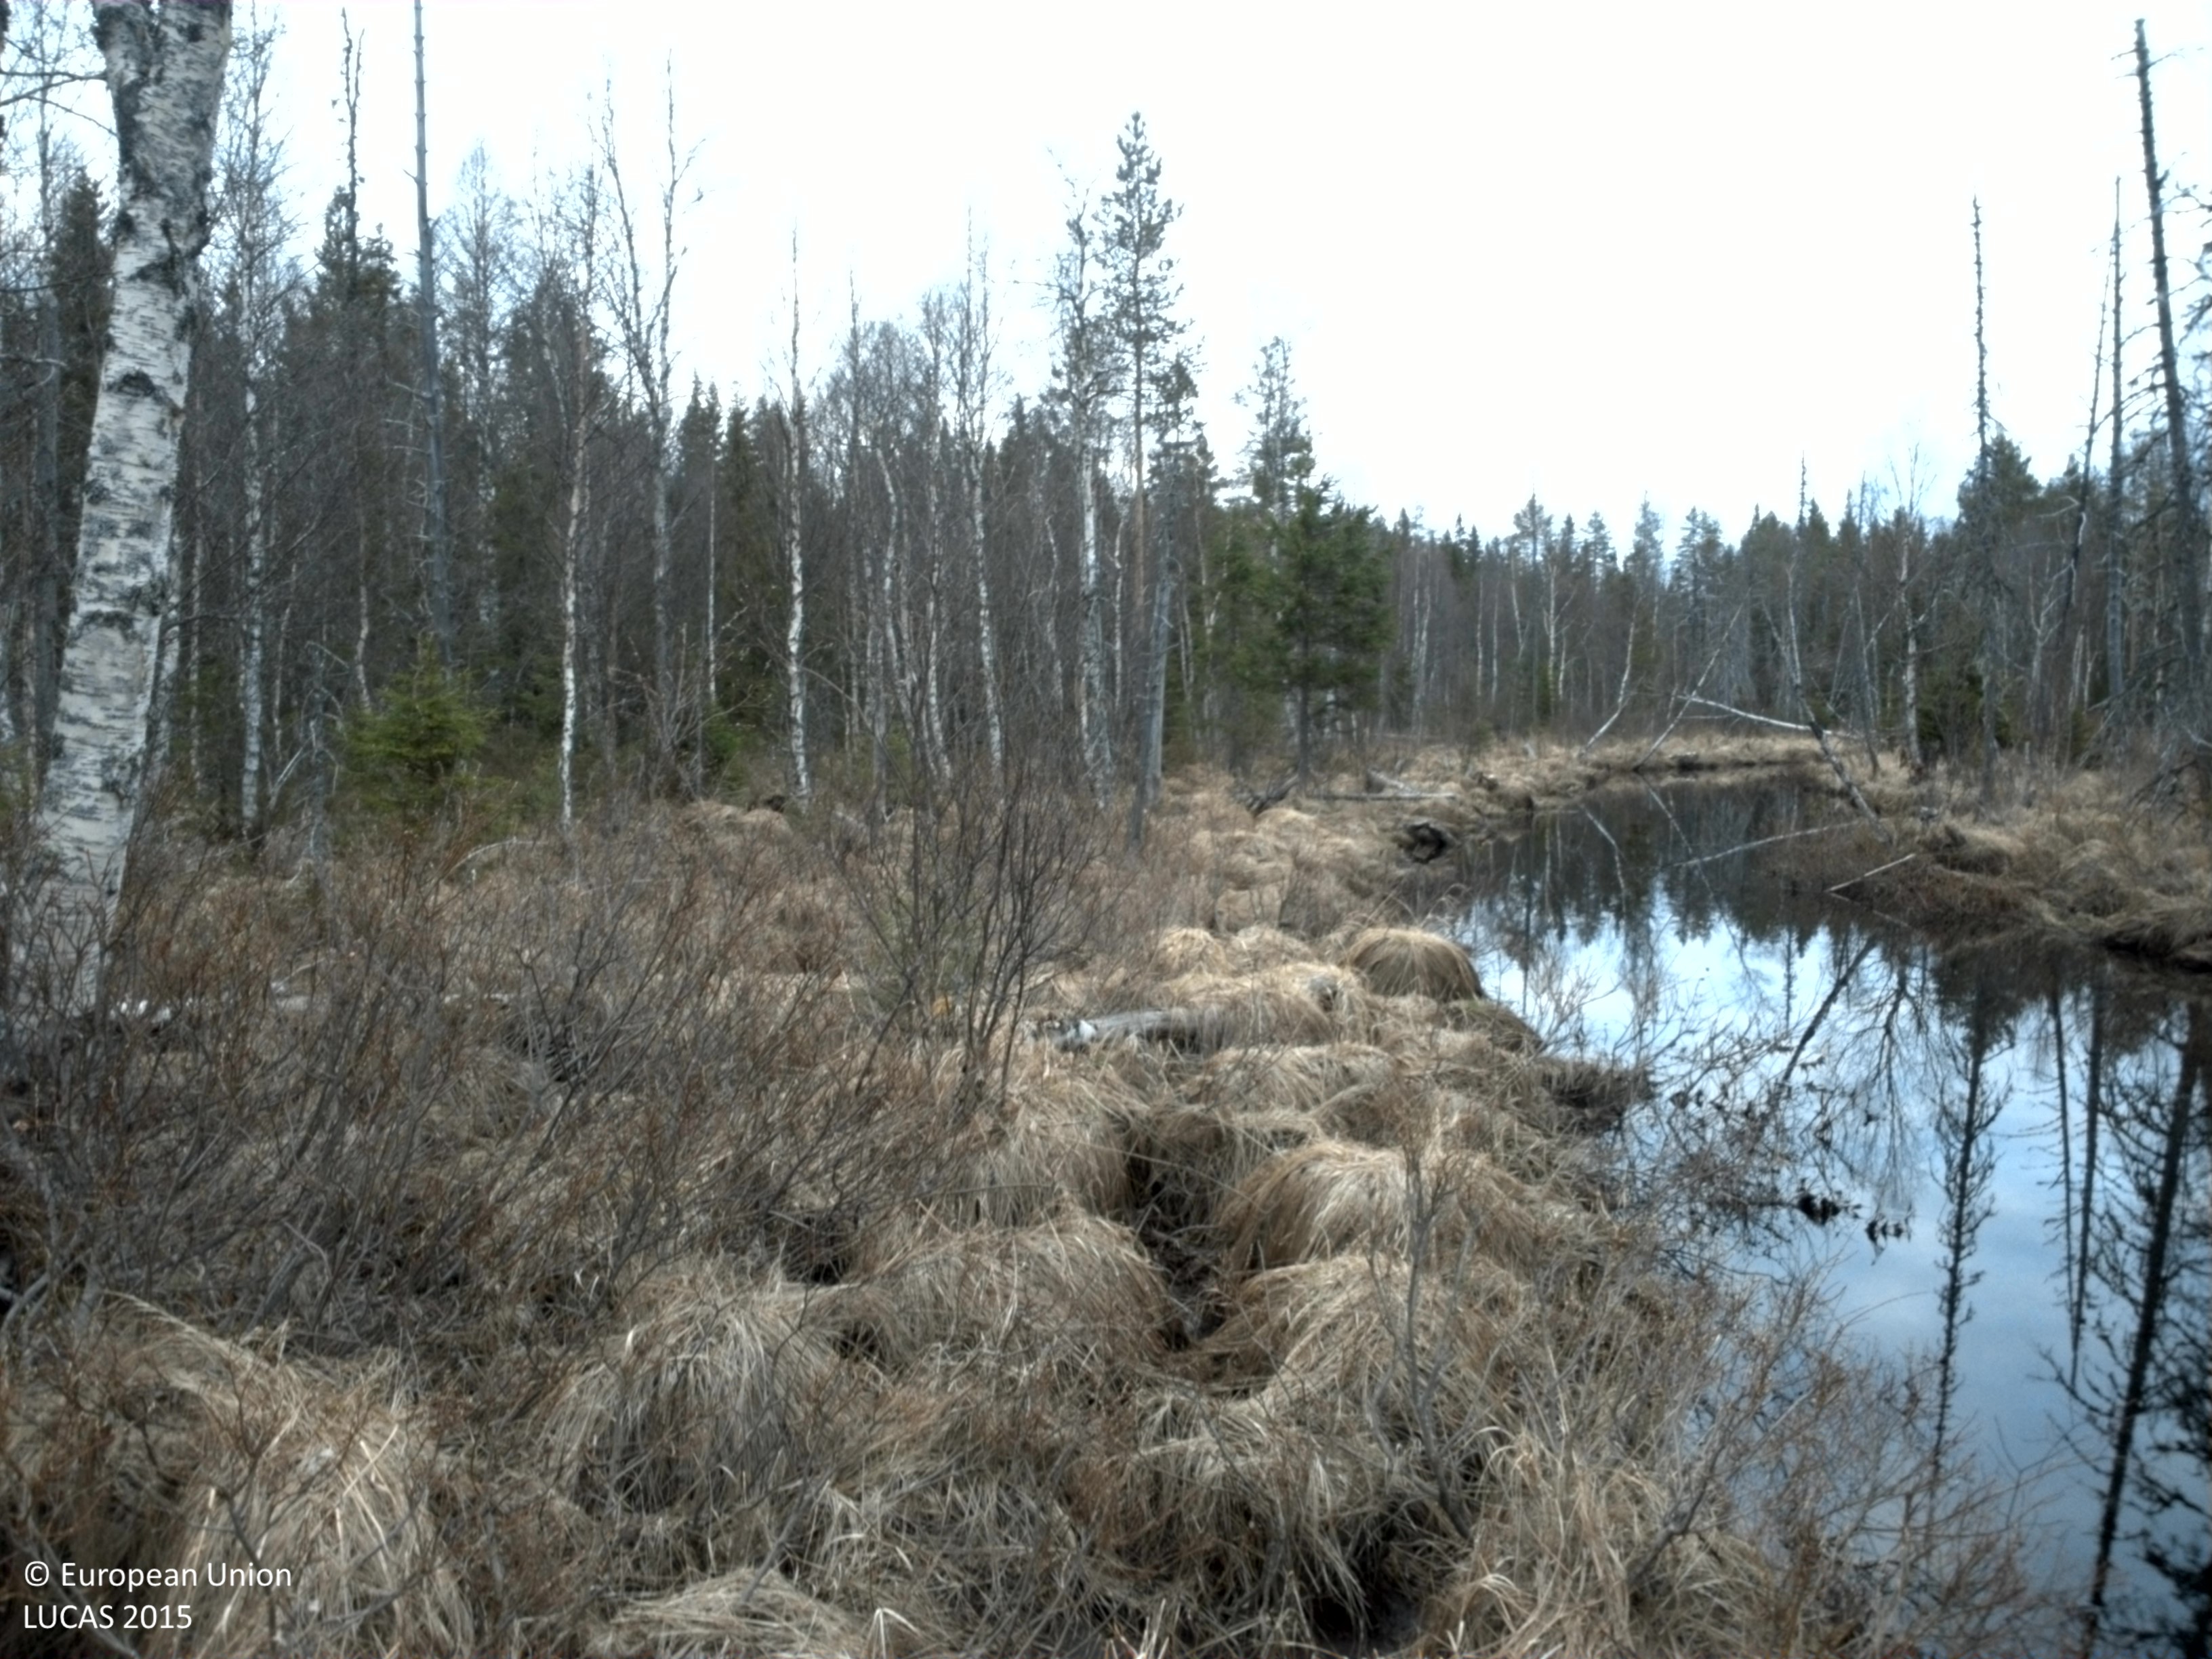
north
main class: Woodland
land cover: Broadleaved woodland
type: boreal forest
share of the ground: > 75 %
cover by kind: broadleaved forest trees 70 %, herbaceous plants 20 %, coniferous forest trees 10 %
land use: Semi-natural and natural areas not in use
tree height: > 5 m
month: May
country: SE
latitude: 62.6752
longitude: 14.9593
